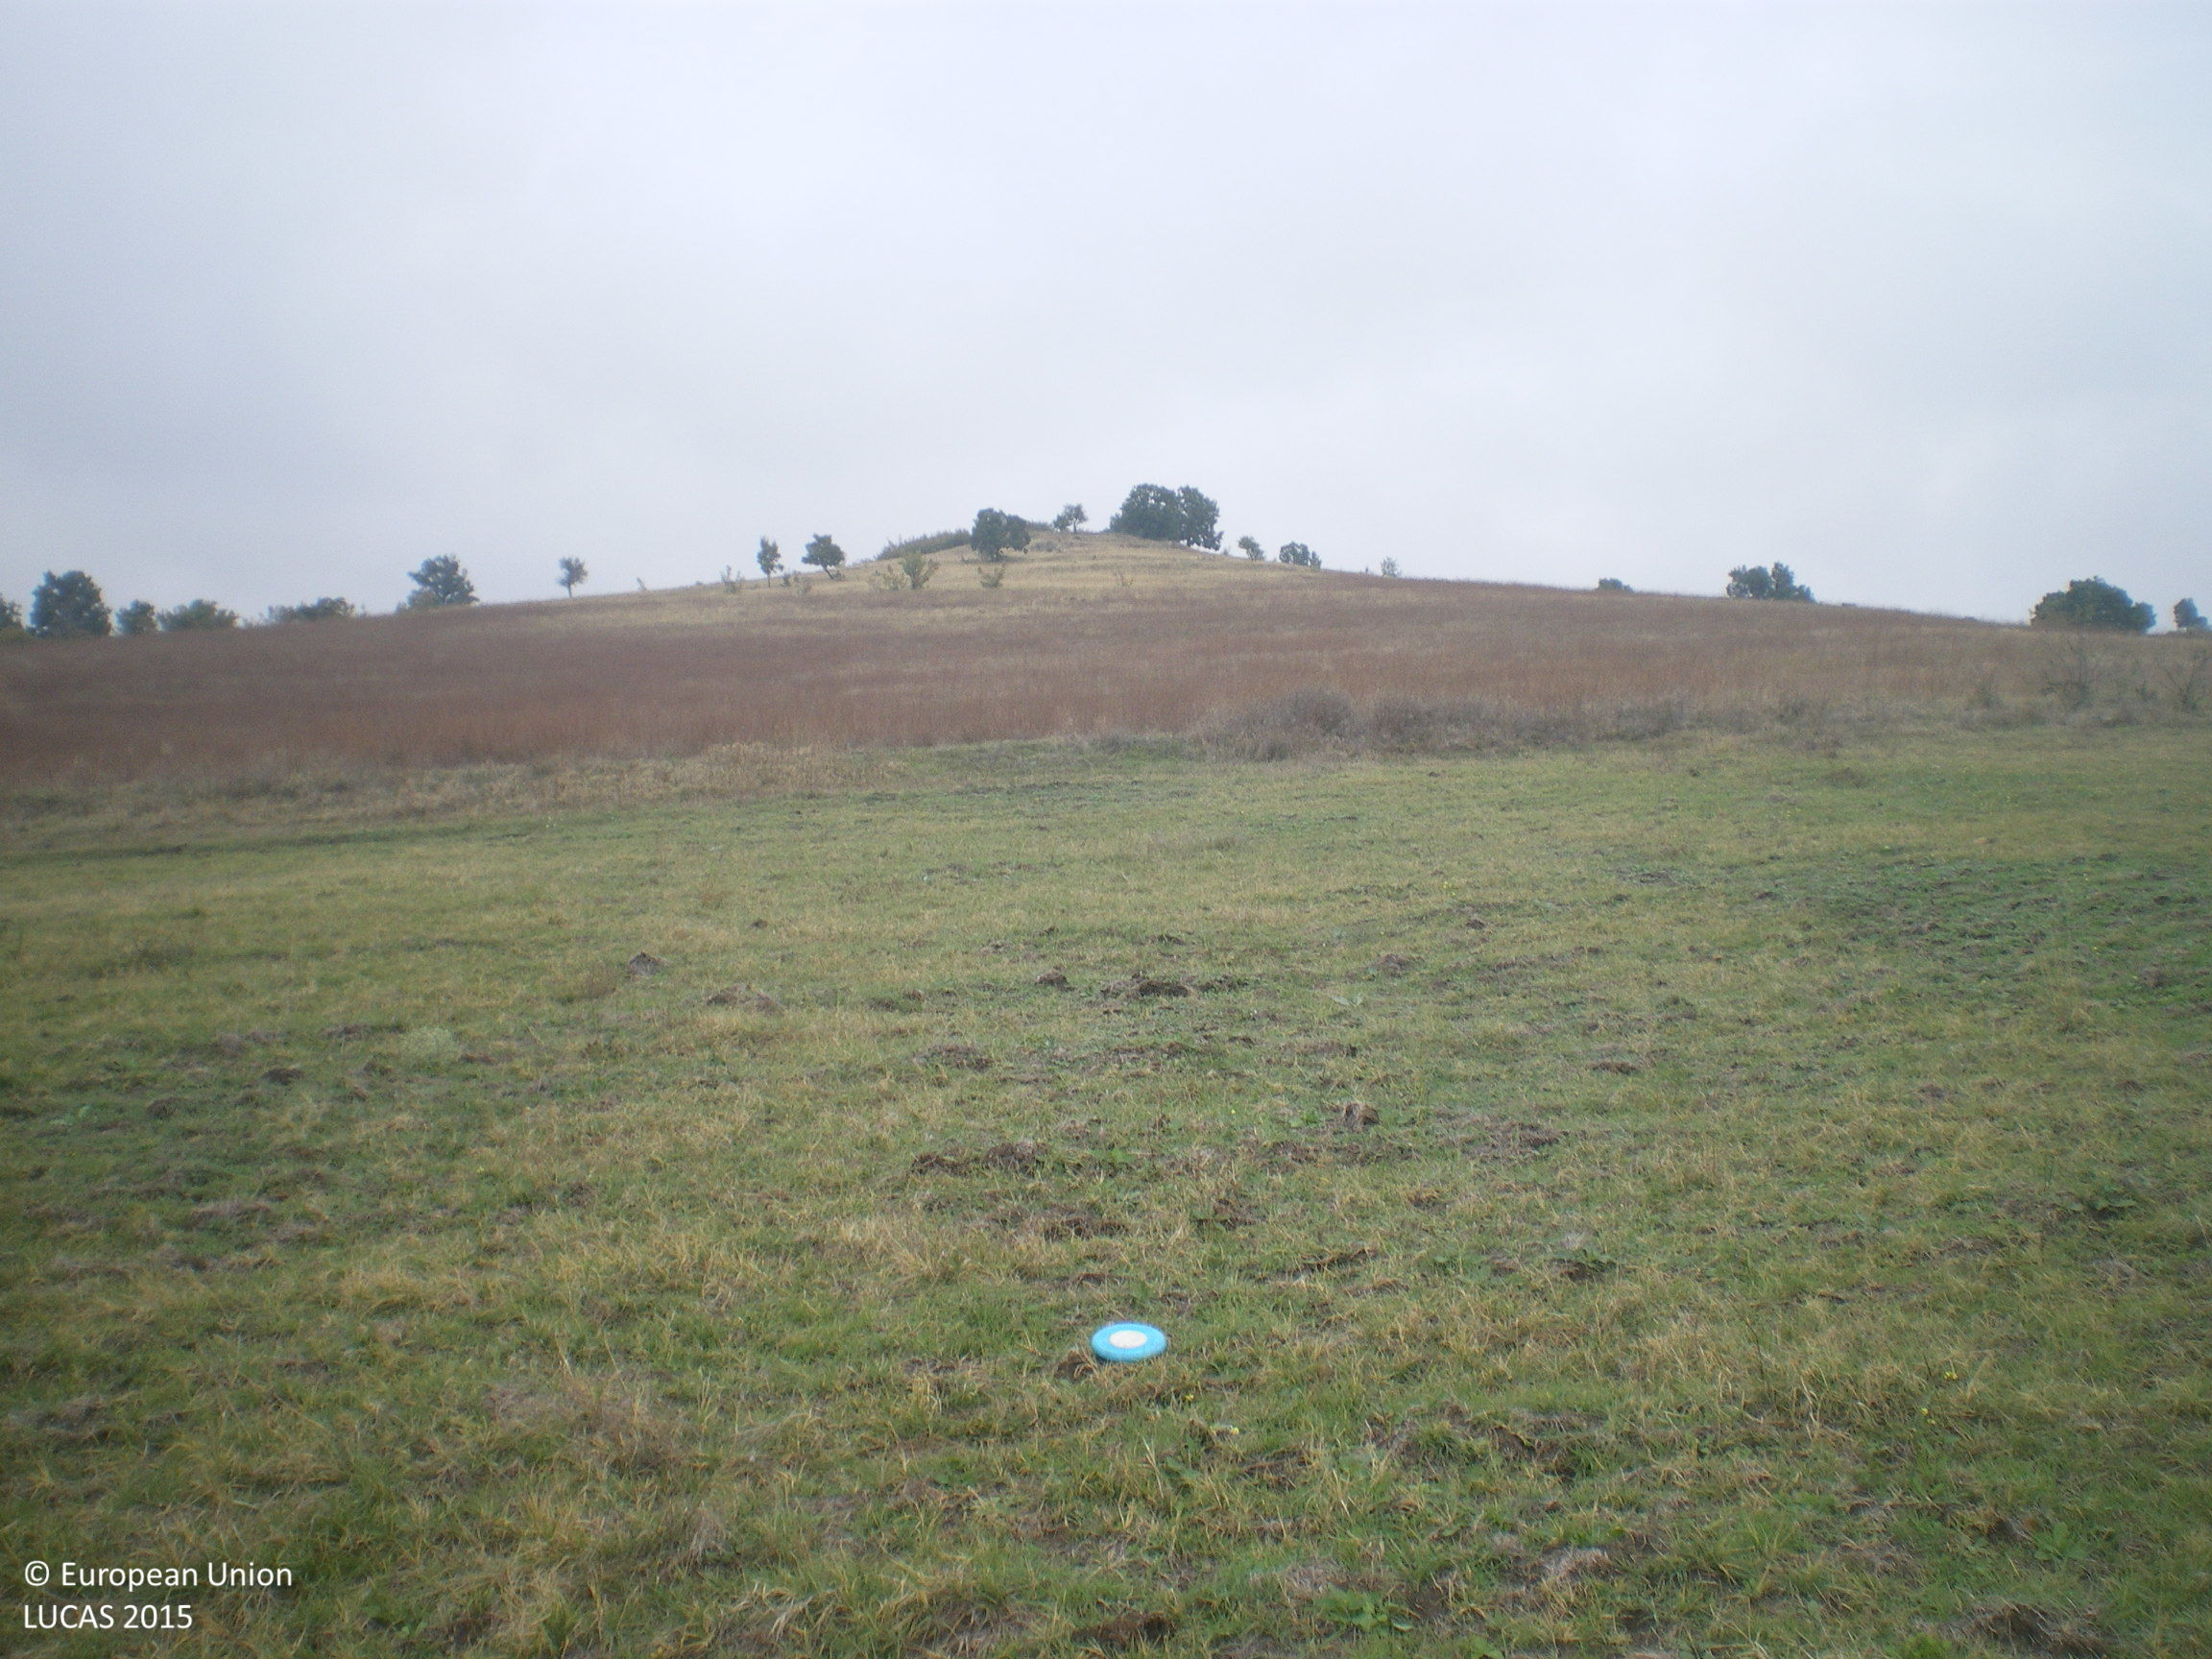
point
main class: Cropland
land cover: Common wheat
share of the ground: < 10 %
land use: Agriculture (excluding fallow land and kitchen gardens)
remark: Harvested field
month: October
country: BG
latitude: 41.8398
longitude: 26.1772
